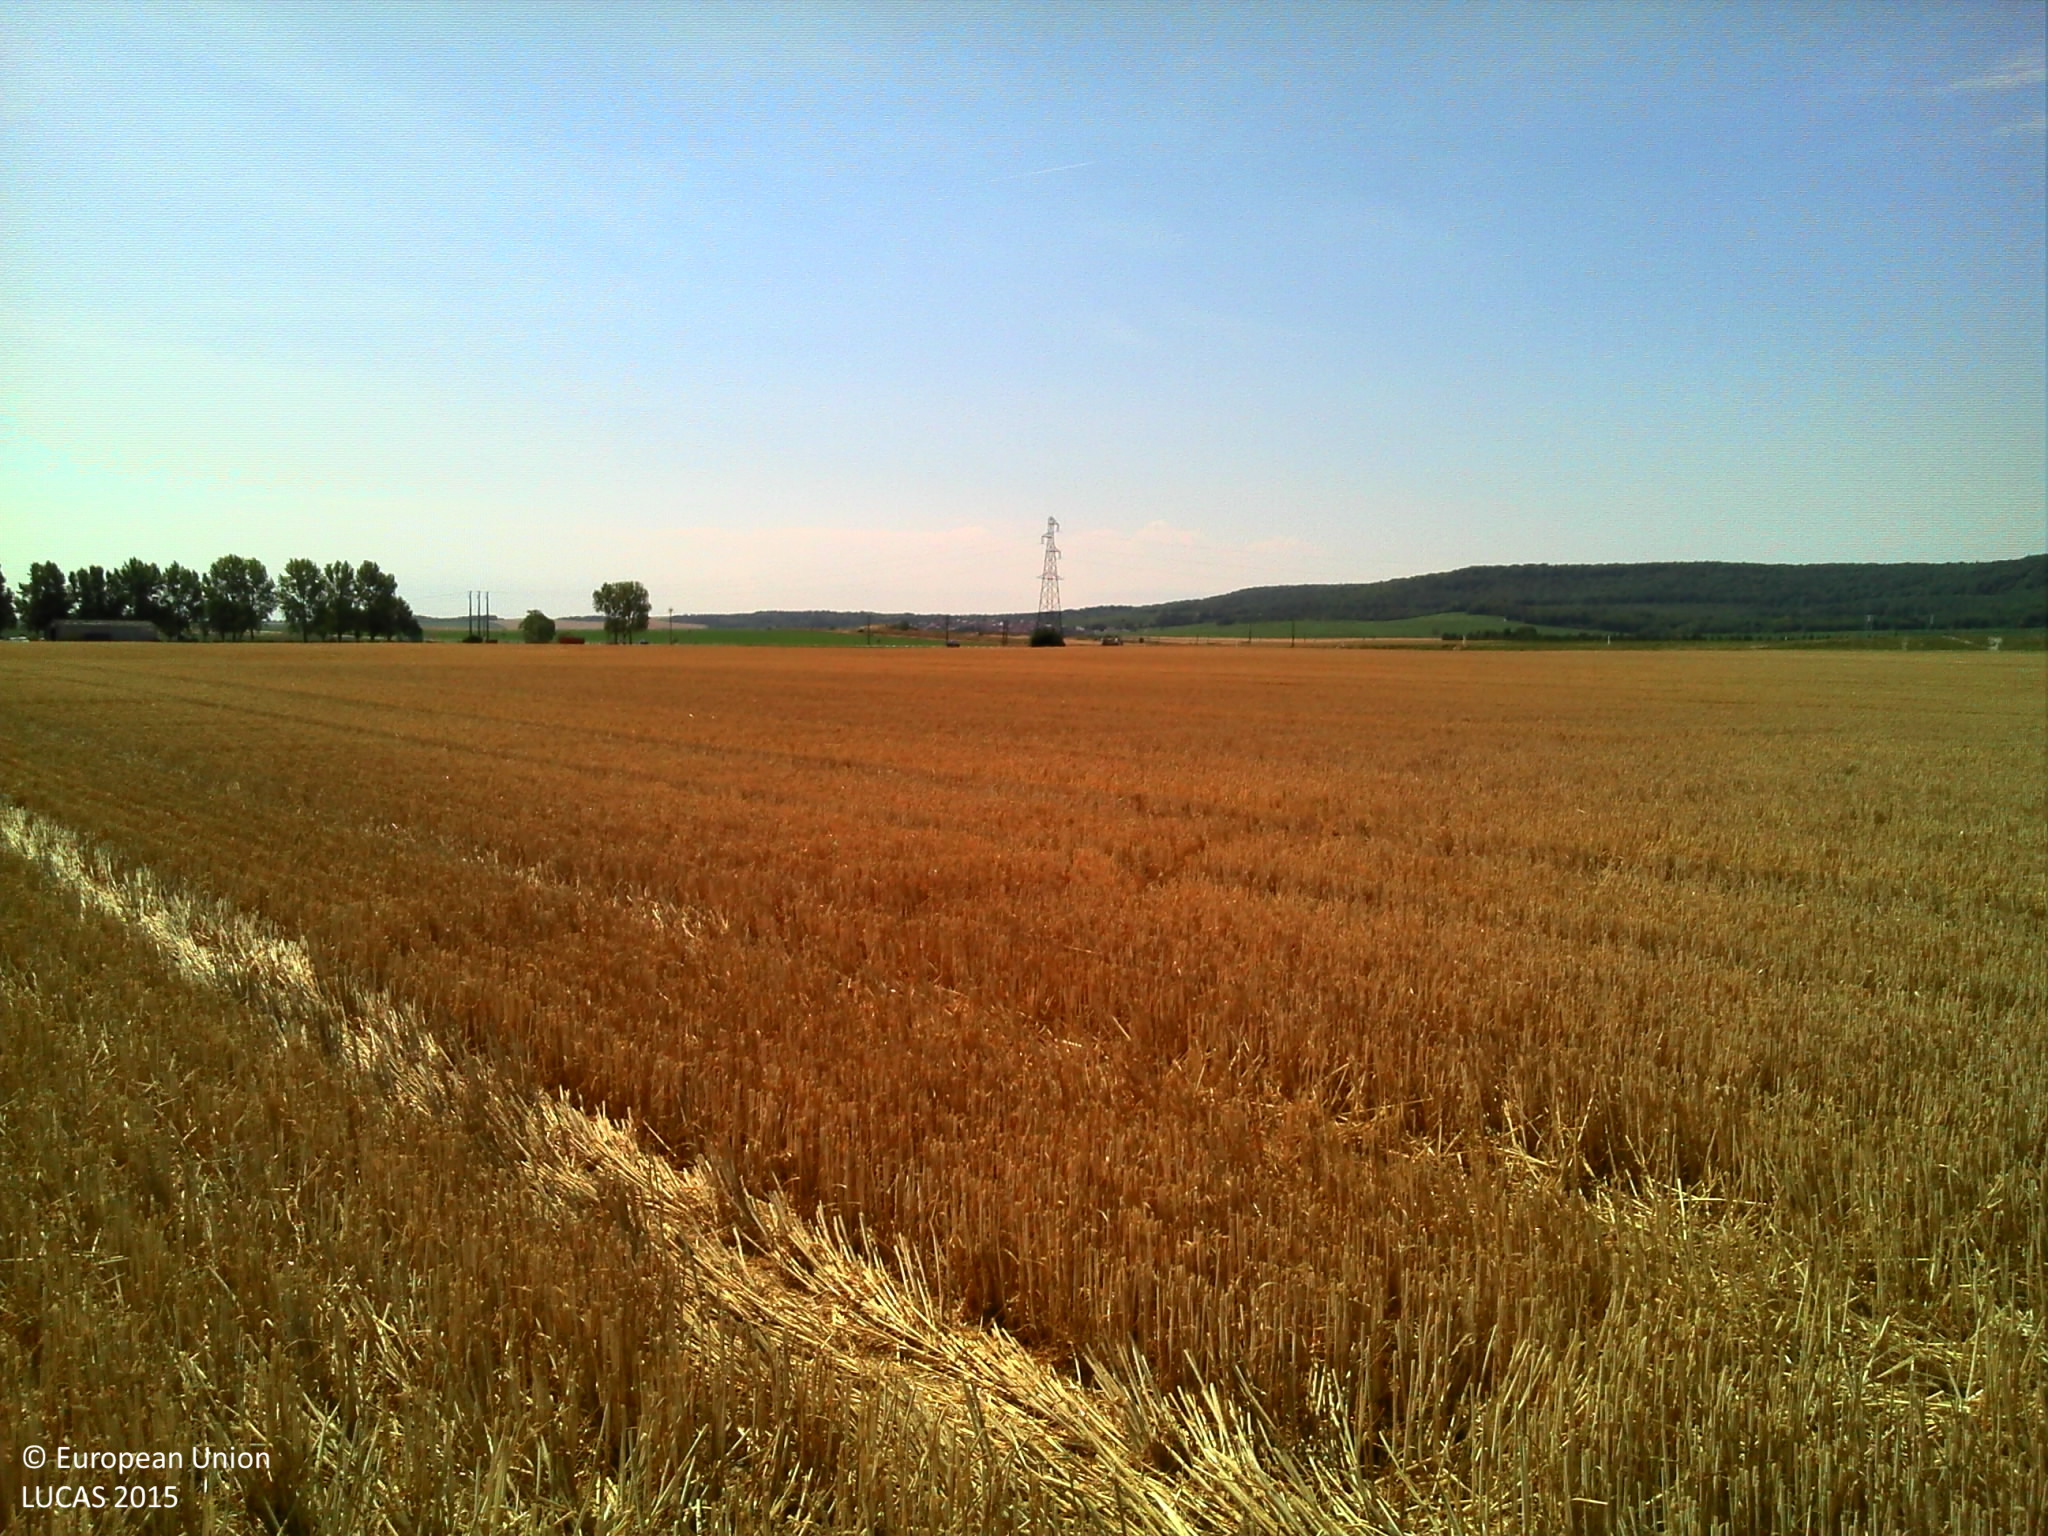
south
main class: Cropland
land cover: Common wheat
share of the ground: > 75 %
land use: Agriculture (excluding fallow land and kitchen gardens)
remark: Harvested field
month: August
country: FR
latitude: 49.1708
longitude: 4.1938
